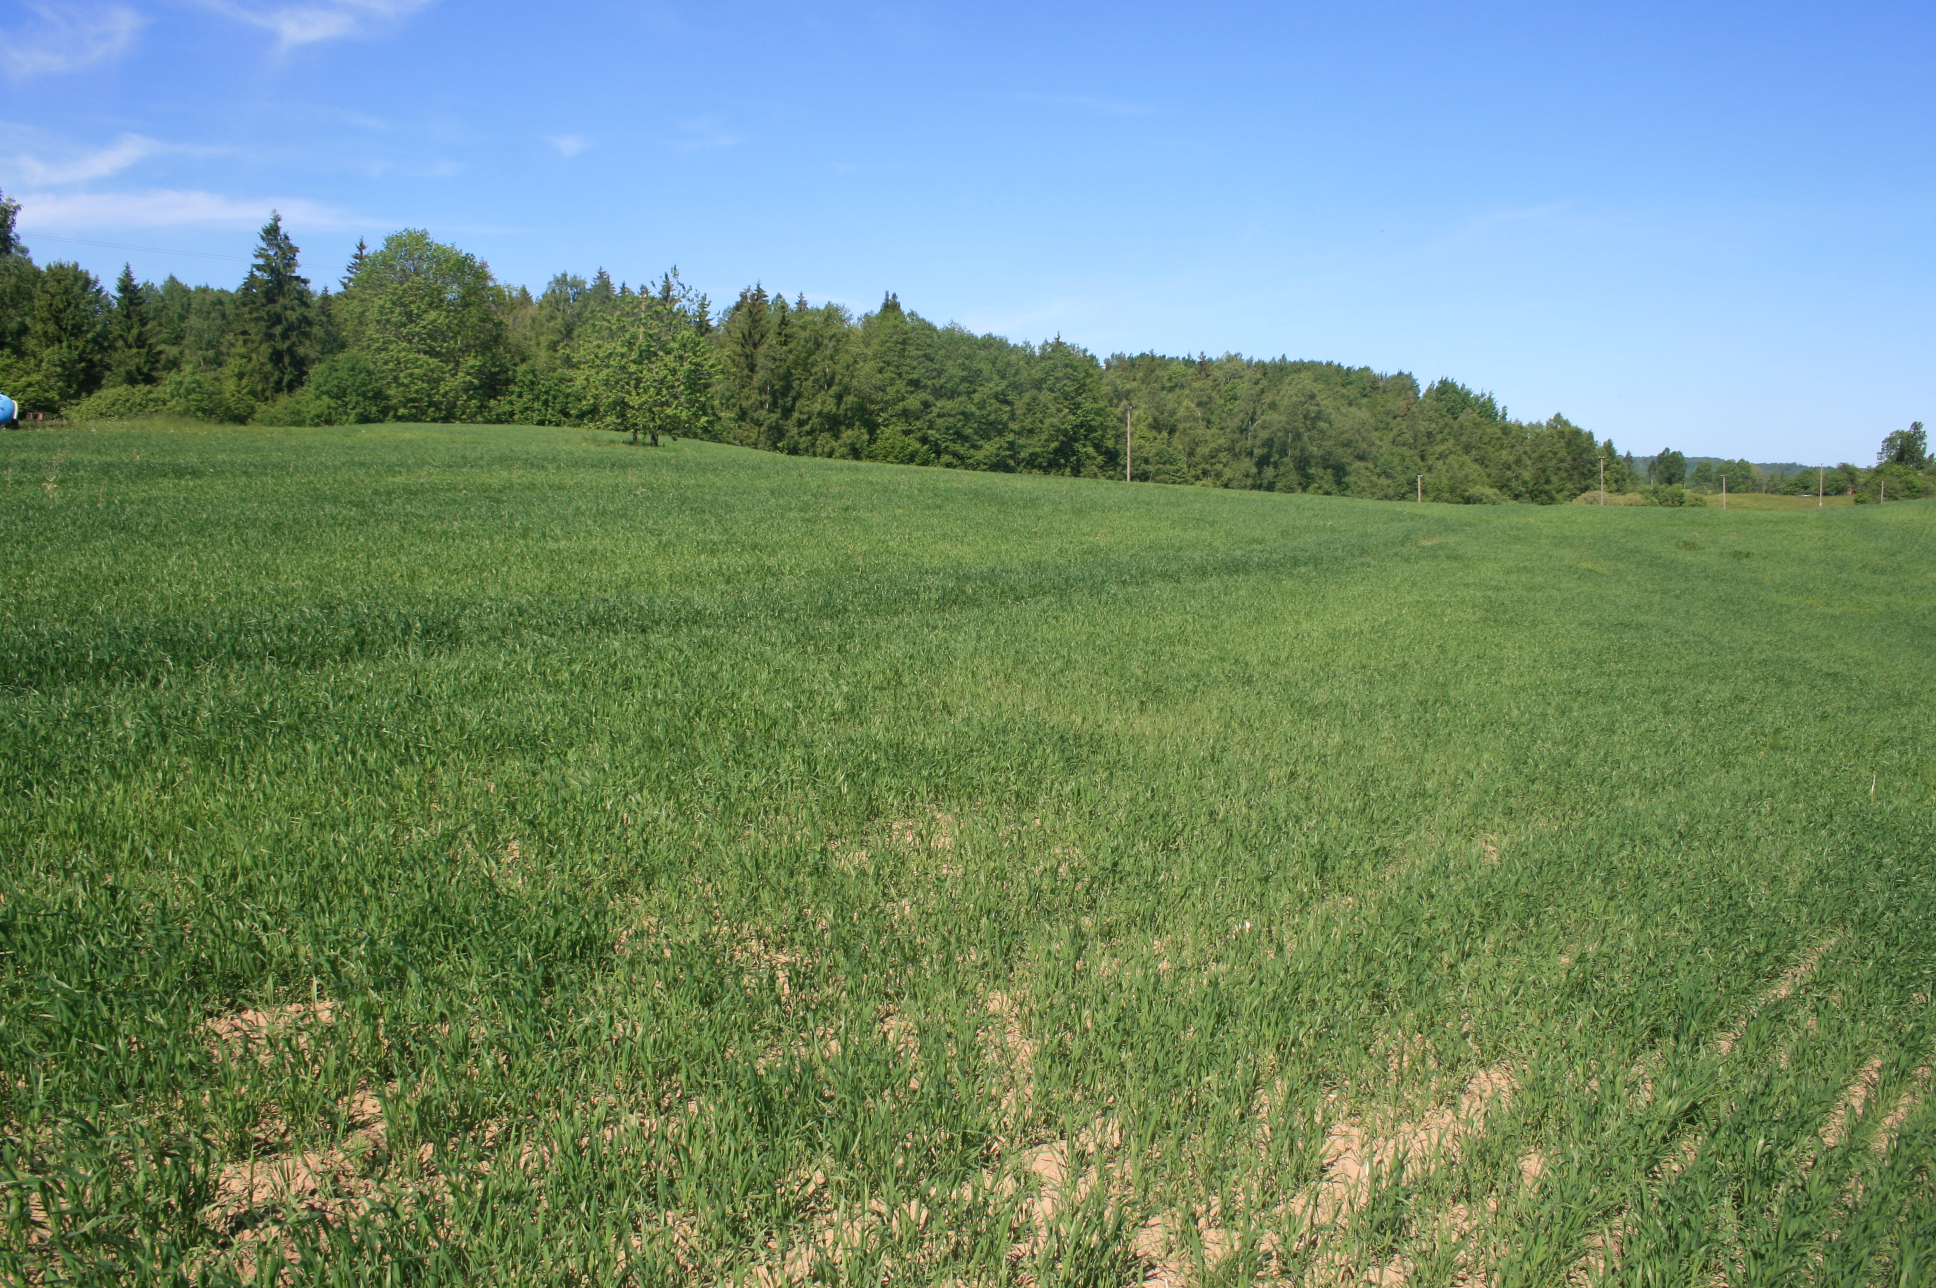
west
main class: Cropland
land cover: Common wheat
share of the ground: > 75 %
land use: Agriculture (excluding fallow land and kitchen gardens)
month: June
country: LT
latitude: 55.9066
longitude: 22.2608
